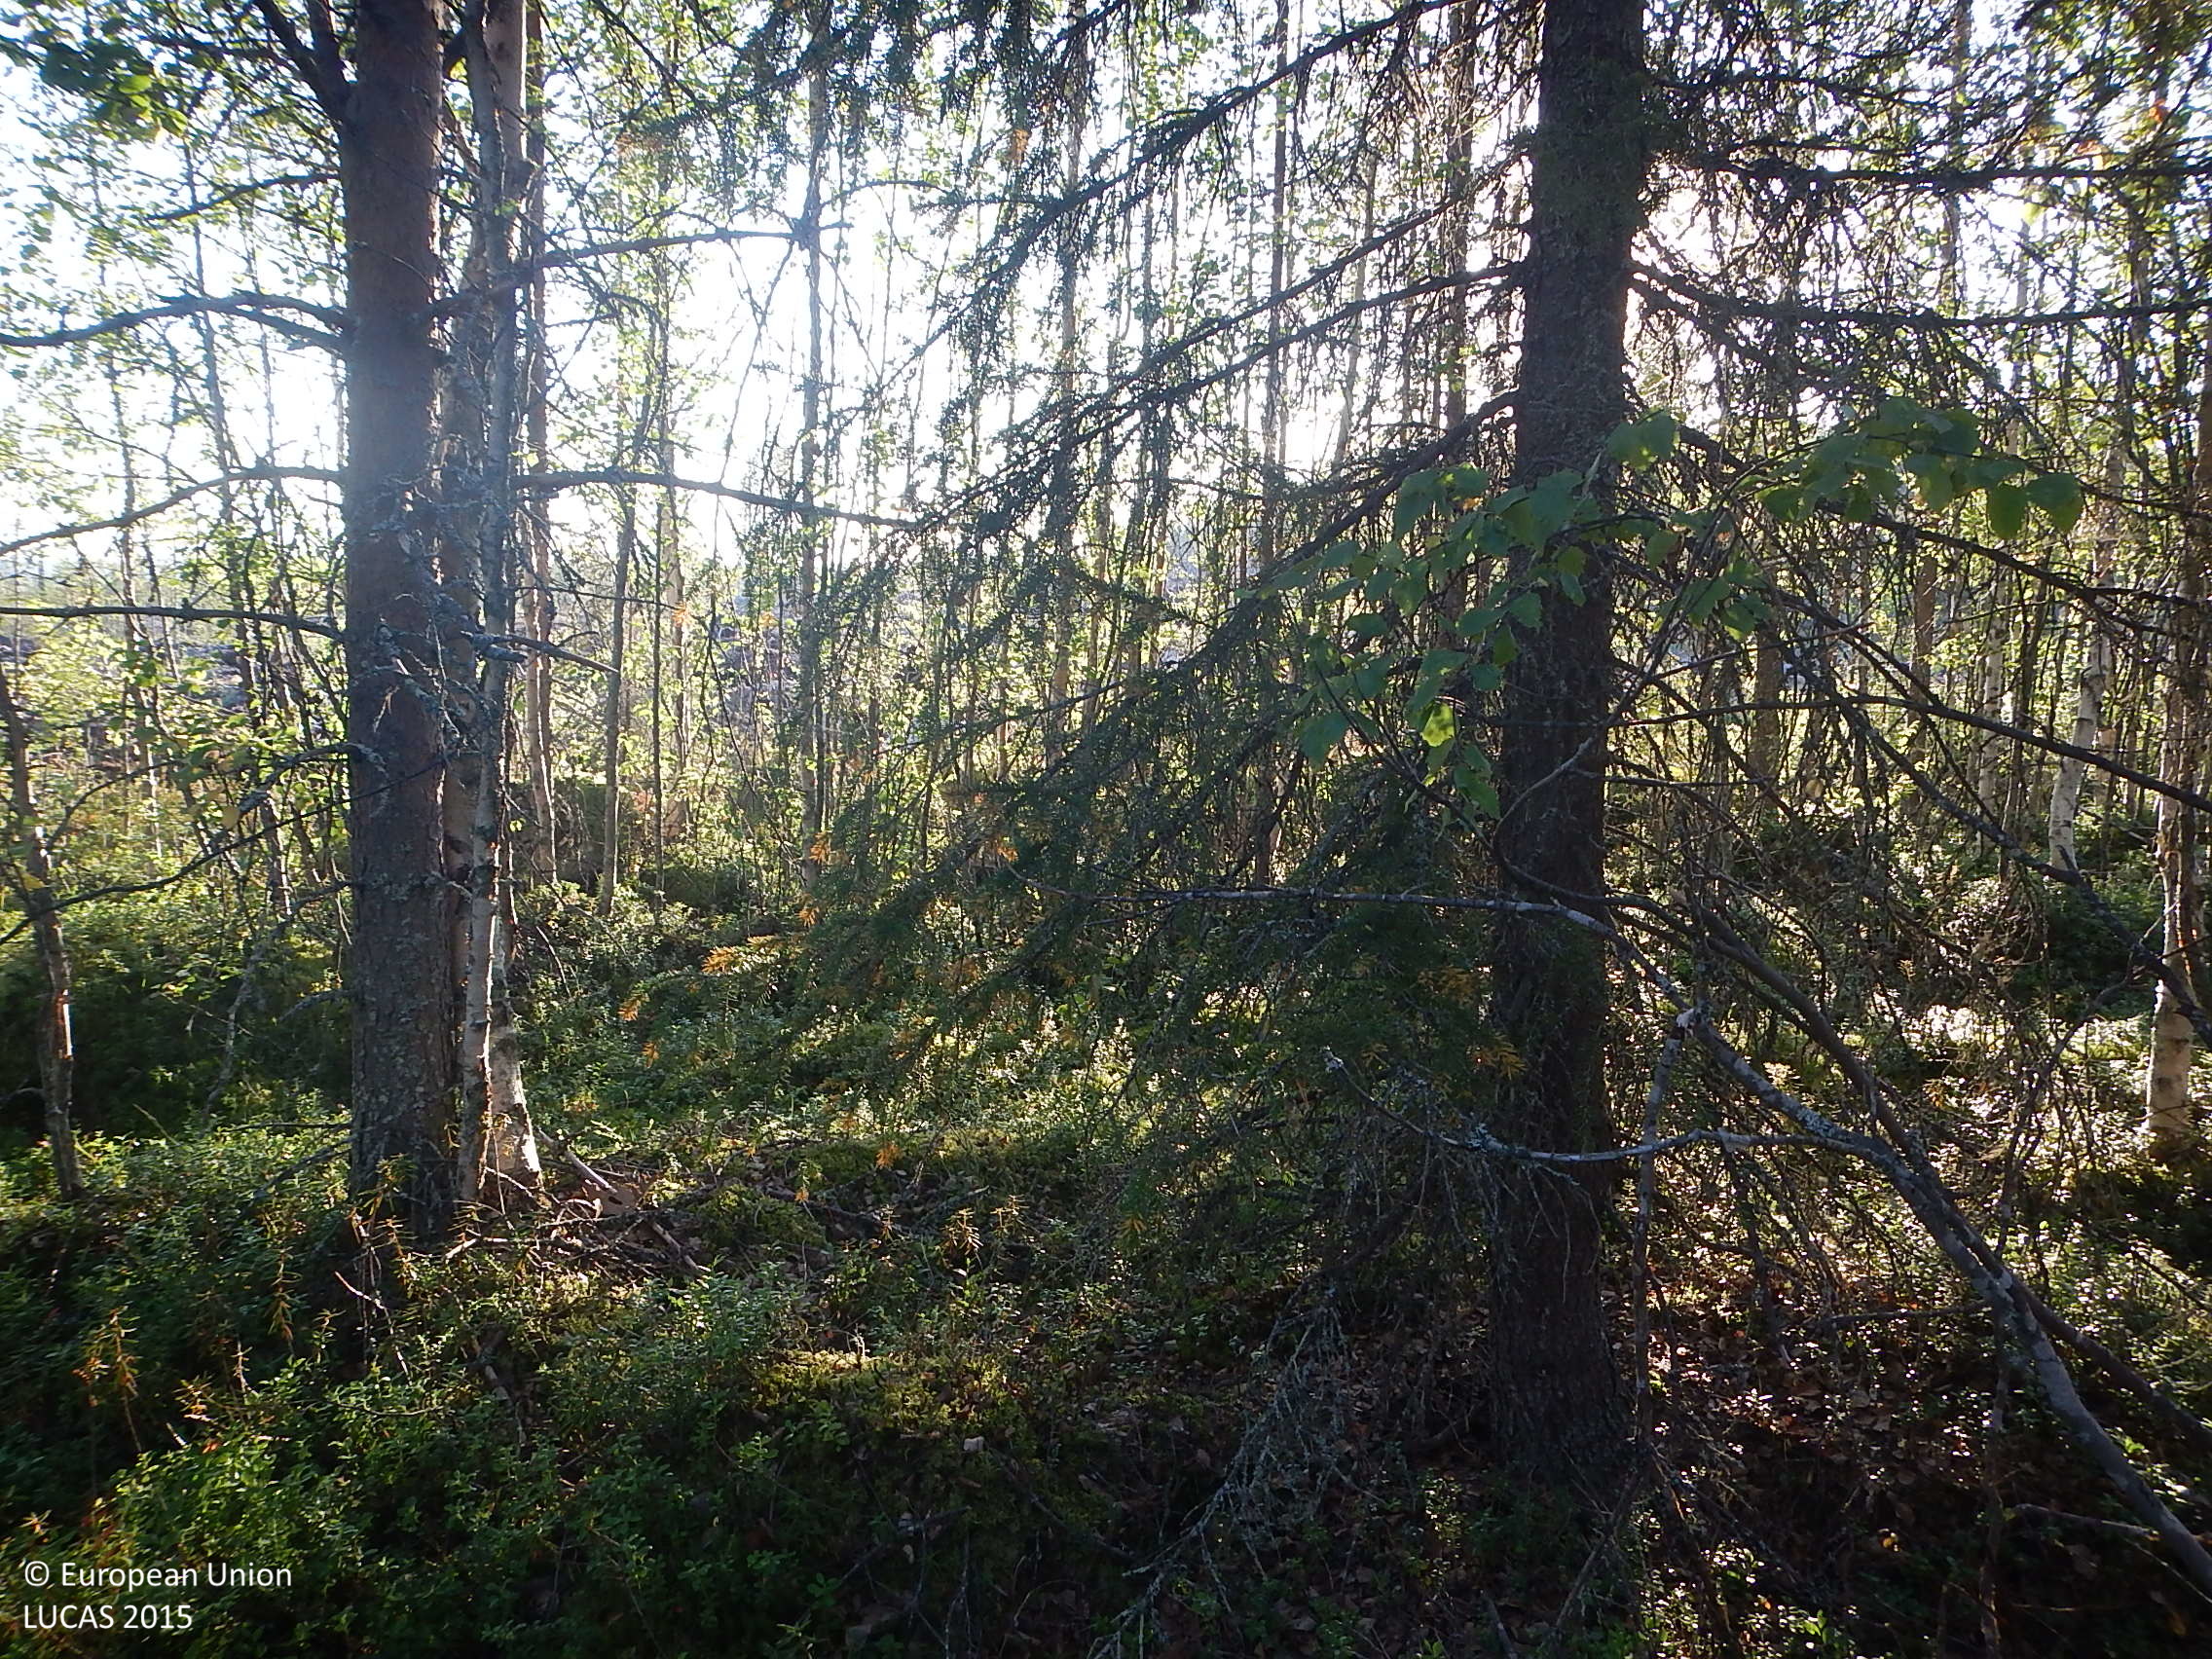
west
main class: Woodland
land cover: Pine dominated mixed woodland
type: boreal forest
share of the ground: > 75 %
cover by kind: coniferous forest trees 50 %, broadleaved forest trees 30 %, shrubs 10 %, lichens and mosses 10 %
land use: Forestry
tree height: > 5 m
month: August
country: FI
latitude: 66.4516
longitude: 28.1930
